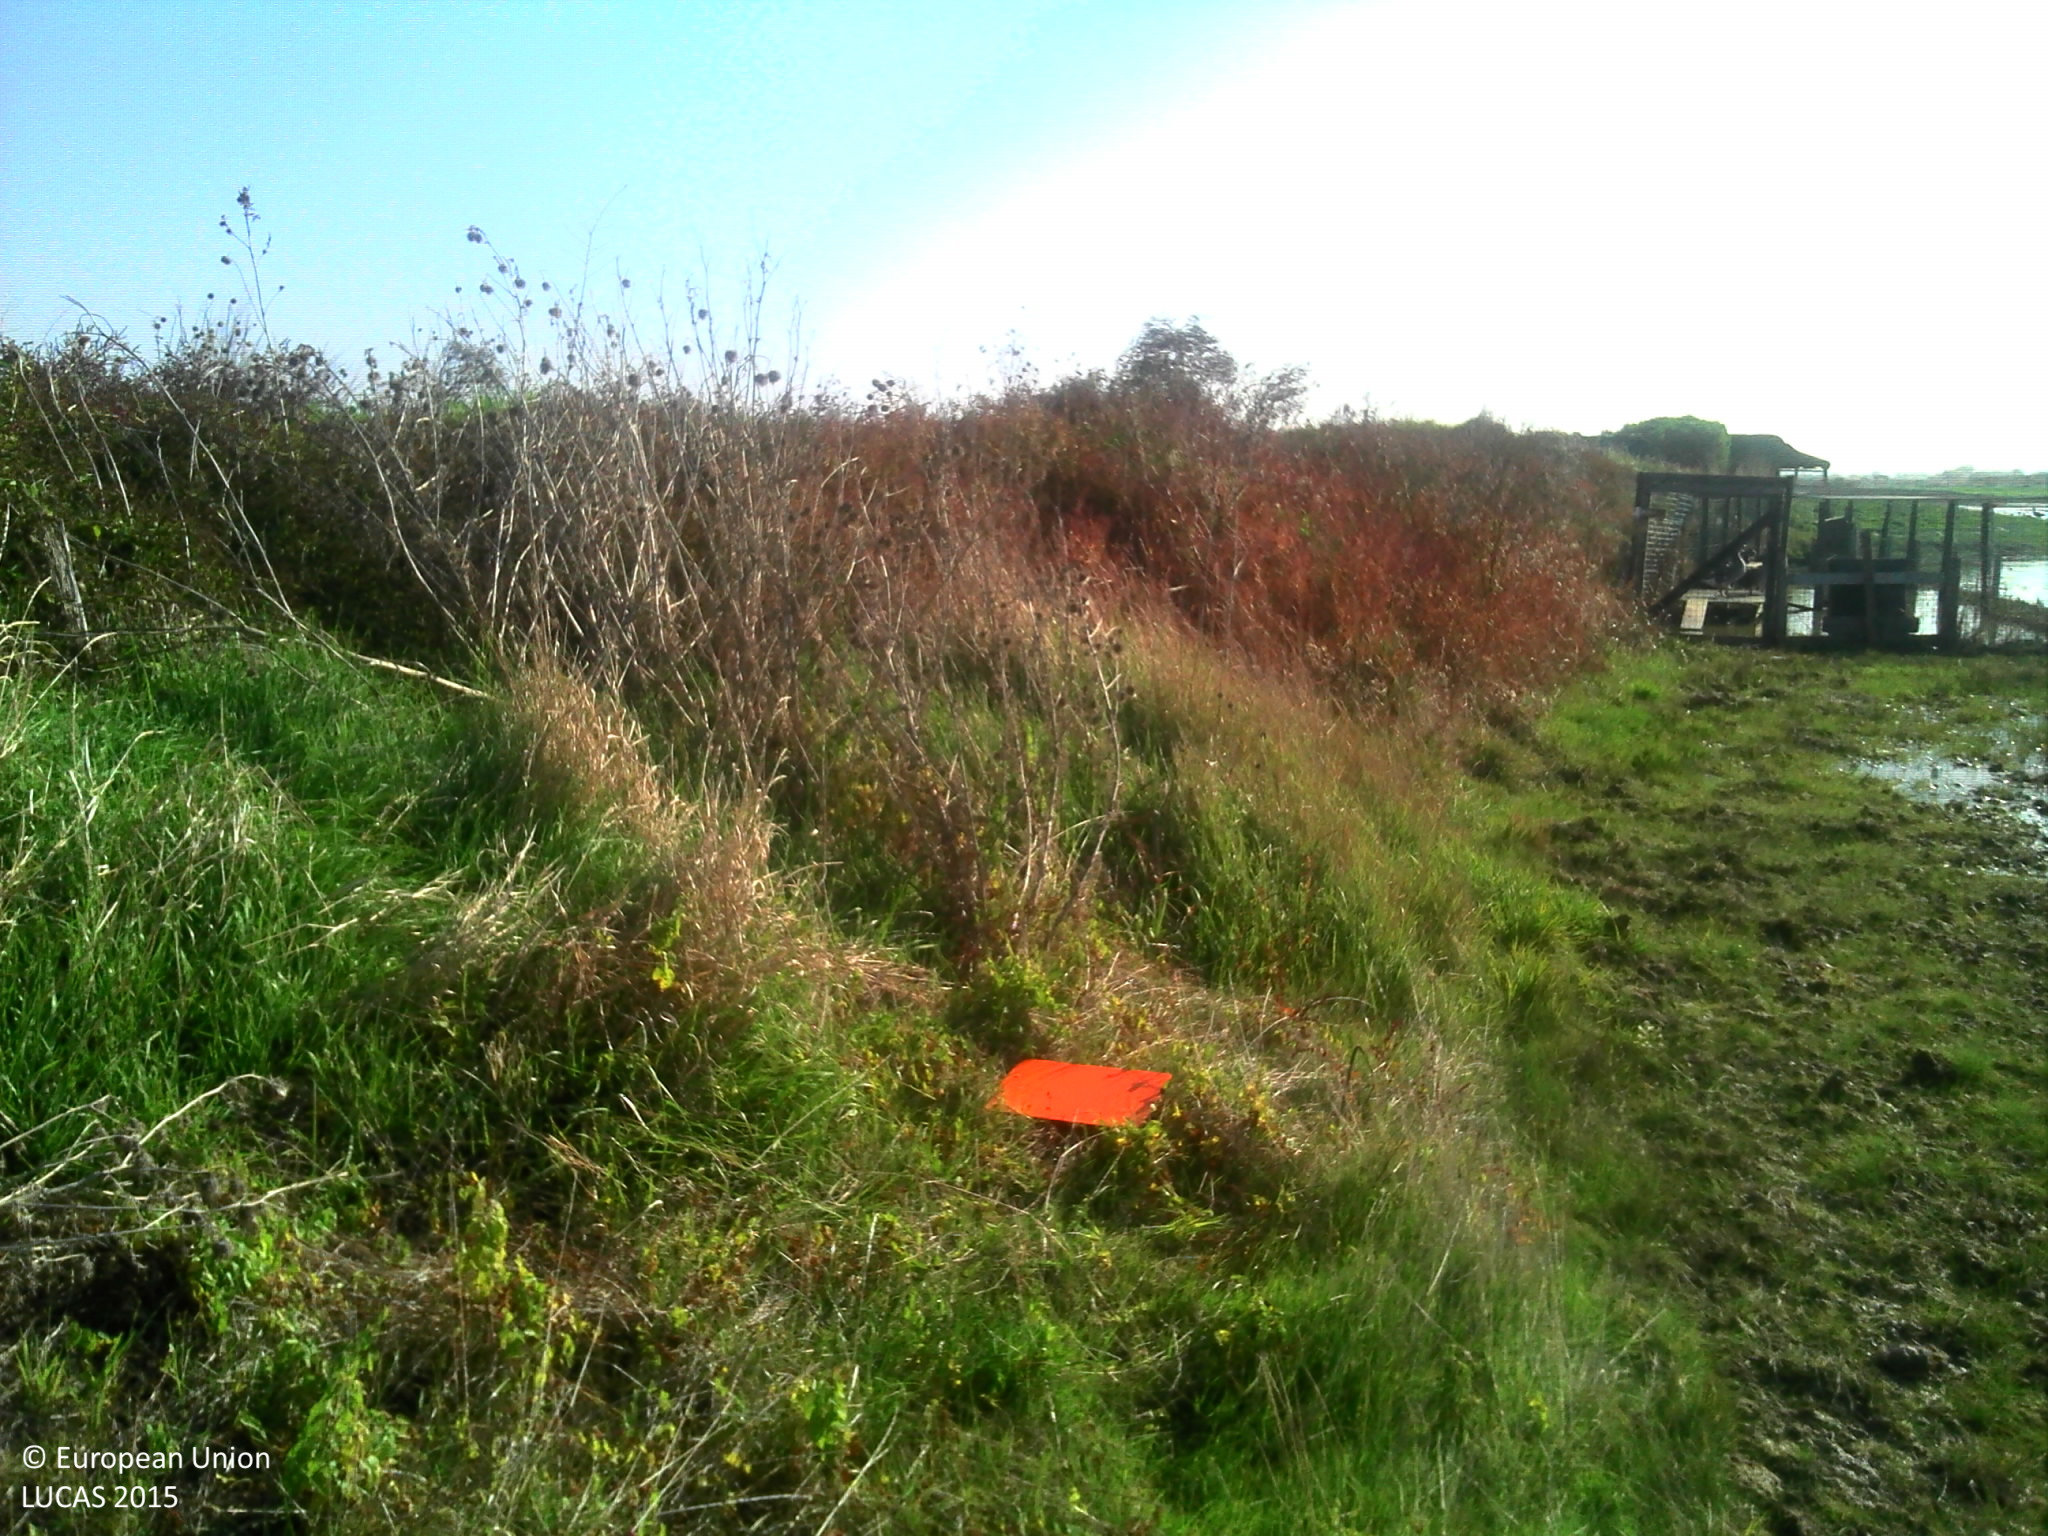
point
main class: Grassland
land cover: Spontaneously vegetated surfaces
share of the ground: > 75 %
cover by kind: herbaceous plants 100 %
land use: Agriculture (excluding fallow land and kitchen gardens)
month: October
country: FR
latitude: 45.4636
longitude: -1.0902
